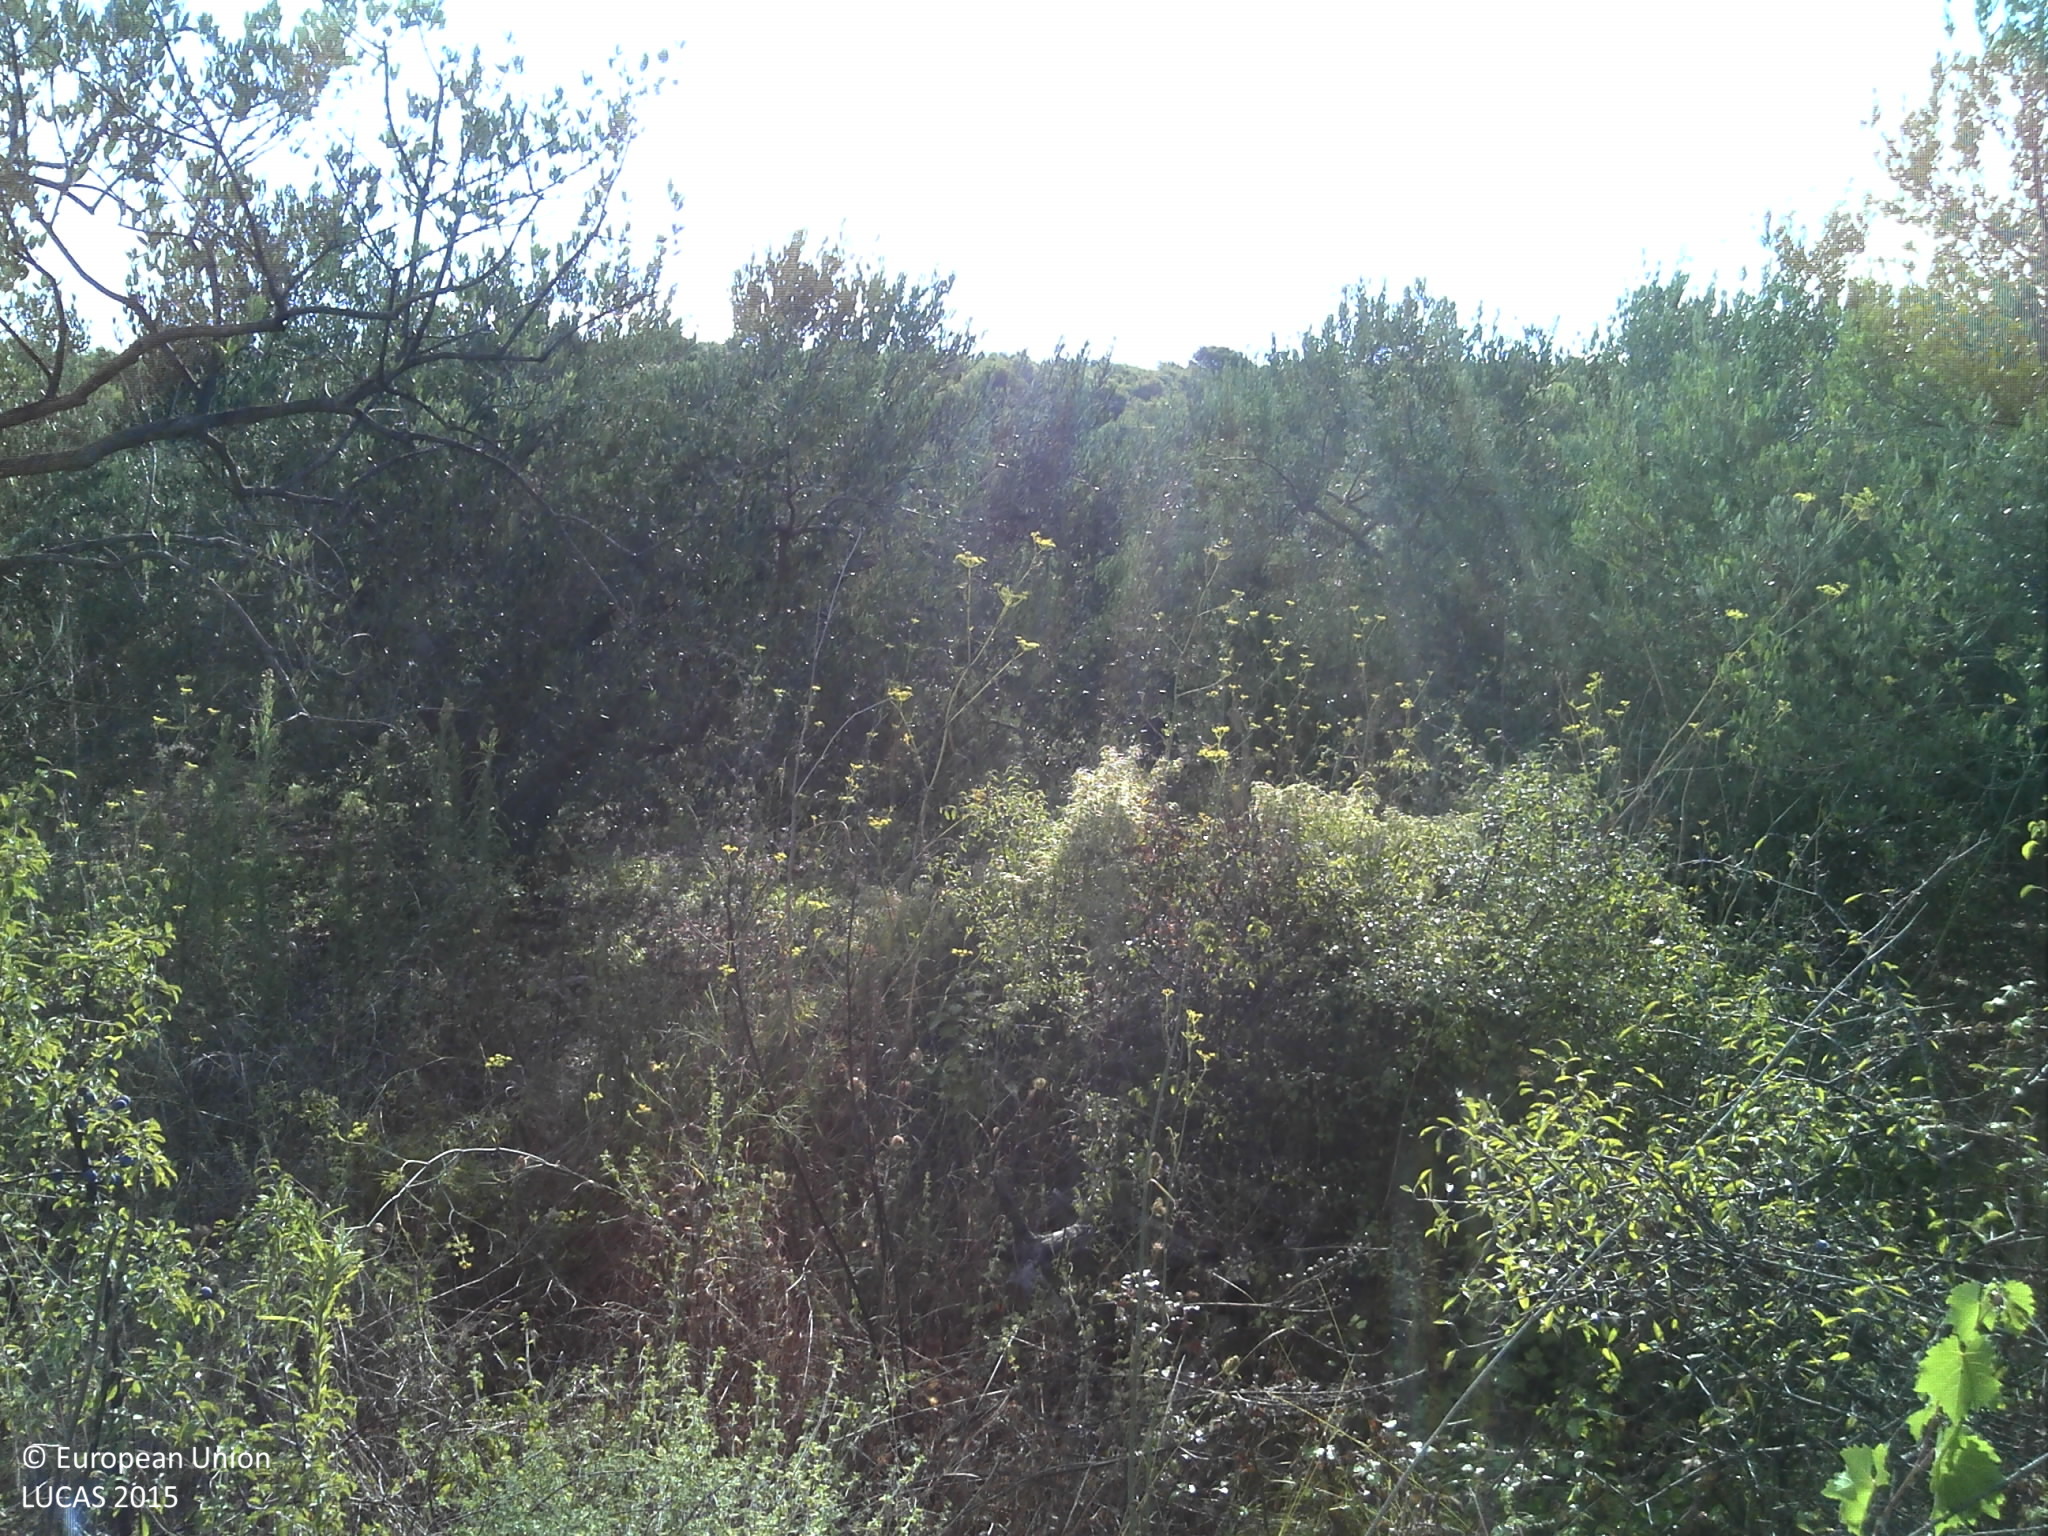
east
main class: Shrubland
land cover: Shrubland with sparse tree cover
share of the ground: > 75 %
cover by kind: shrubs 70 %, herbaceous plants 15 %, broadleaved forest trees 5 %, consolidated bare surface 5 %, unconsolidated bare surface 5 %
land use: Semi-natural and natural areas not in use
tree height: < 5 m
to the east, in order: Shrubland with sparse tree cover; Olive groves; Dry stone walls; Shrubland with sparse tree cover; Vineyards; Tracks; Pine dominated coniferous woodland; Olive groves; Pine dominated coniferous woodland
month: August
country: HR
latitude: 43.3603
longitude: 16.3447
